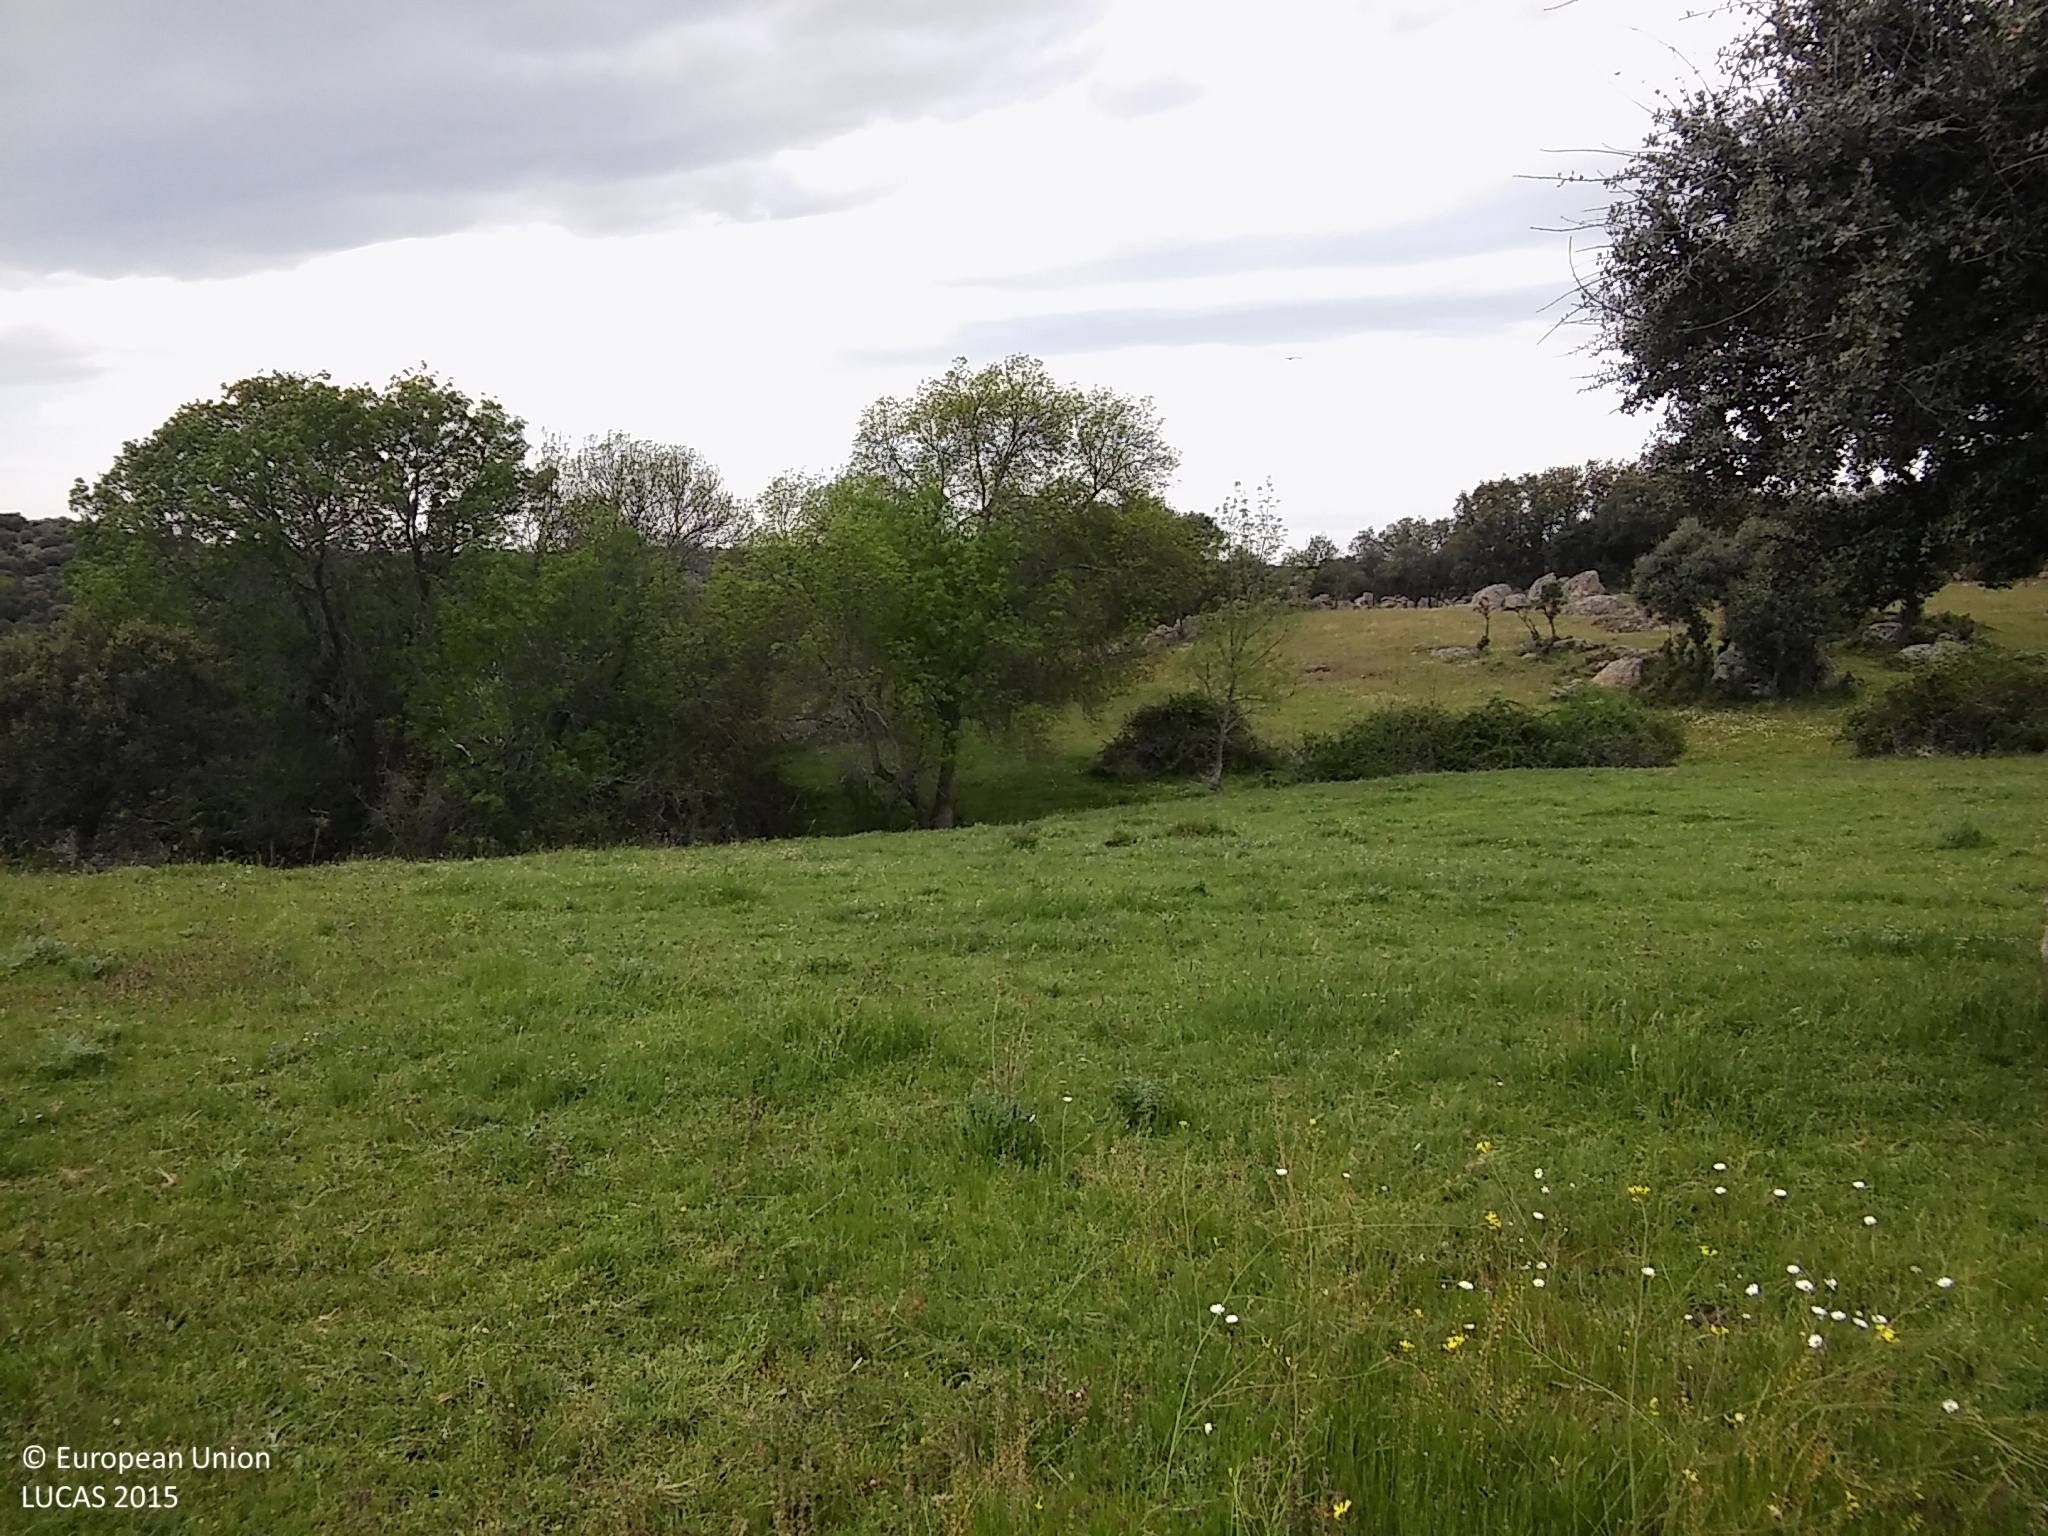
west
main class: Grassland
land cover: Grassland with sparse tree/shrub cover
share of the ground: > 75 %
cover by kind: herbaceous plants 90 %, broadleaved forest trees 5 %, shrubs 5 %
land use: Agriculture (excluding fallow land and kitchen gardens)
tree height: > 5 m
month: May
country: ES
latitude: 41.0673
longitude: -4.0337
